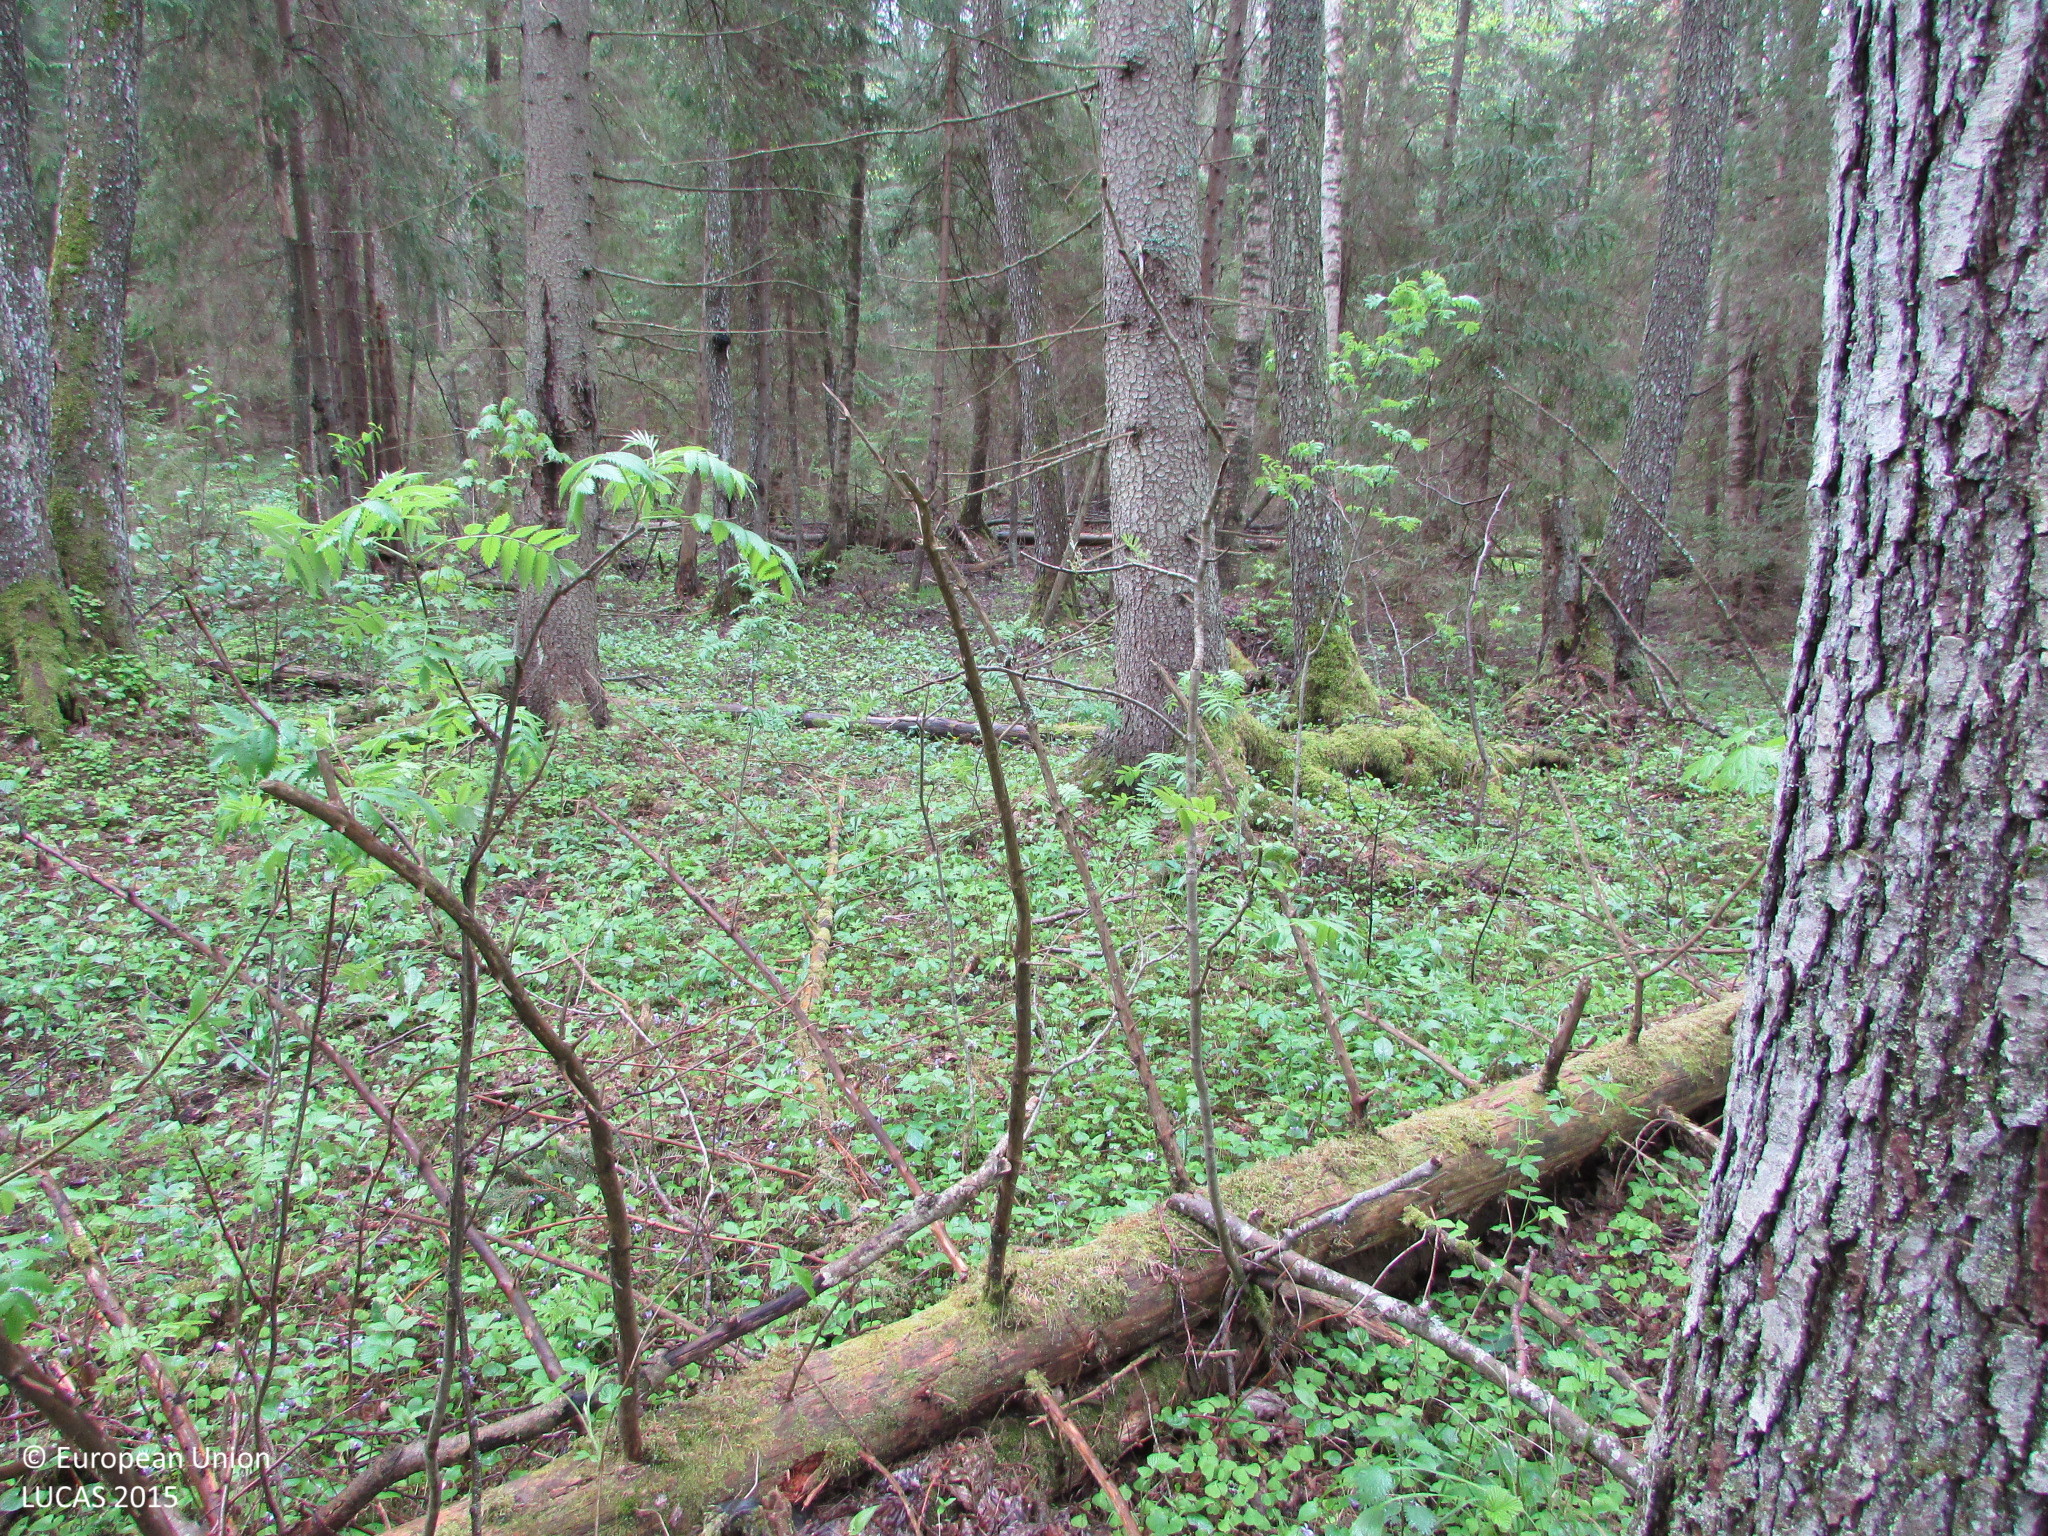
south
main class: Woodland
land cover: Spruce dominated mixed woodland
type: hemiboreal forest and nemoral coniferous forest and mixed broadleaved-coniferous forest
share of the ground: > 75 %
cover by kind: coniferous forest trees 55 %, broadleaved forest trees 25 %, herbaceous plants 10 %, unconsolidated bare surface 5 %
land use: Forestry
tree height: > 5 m
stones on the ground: < 10 %
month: May
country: LV
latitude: 56.2489
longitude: 27.3304
